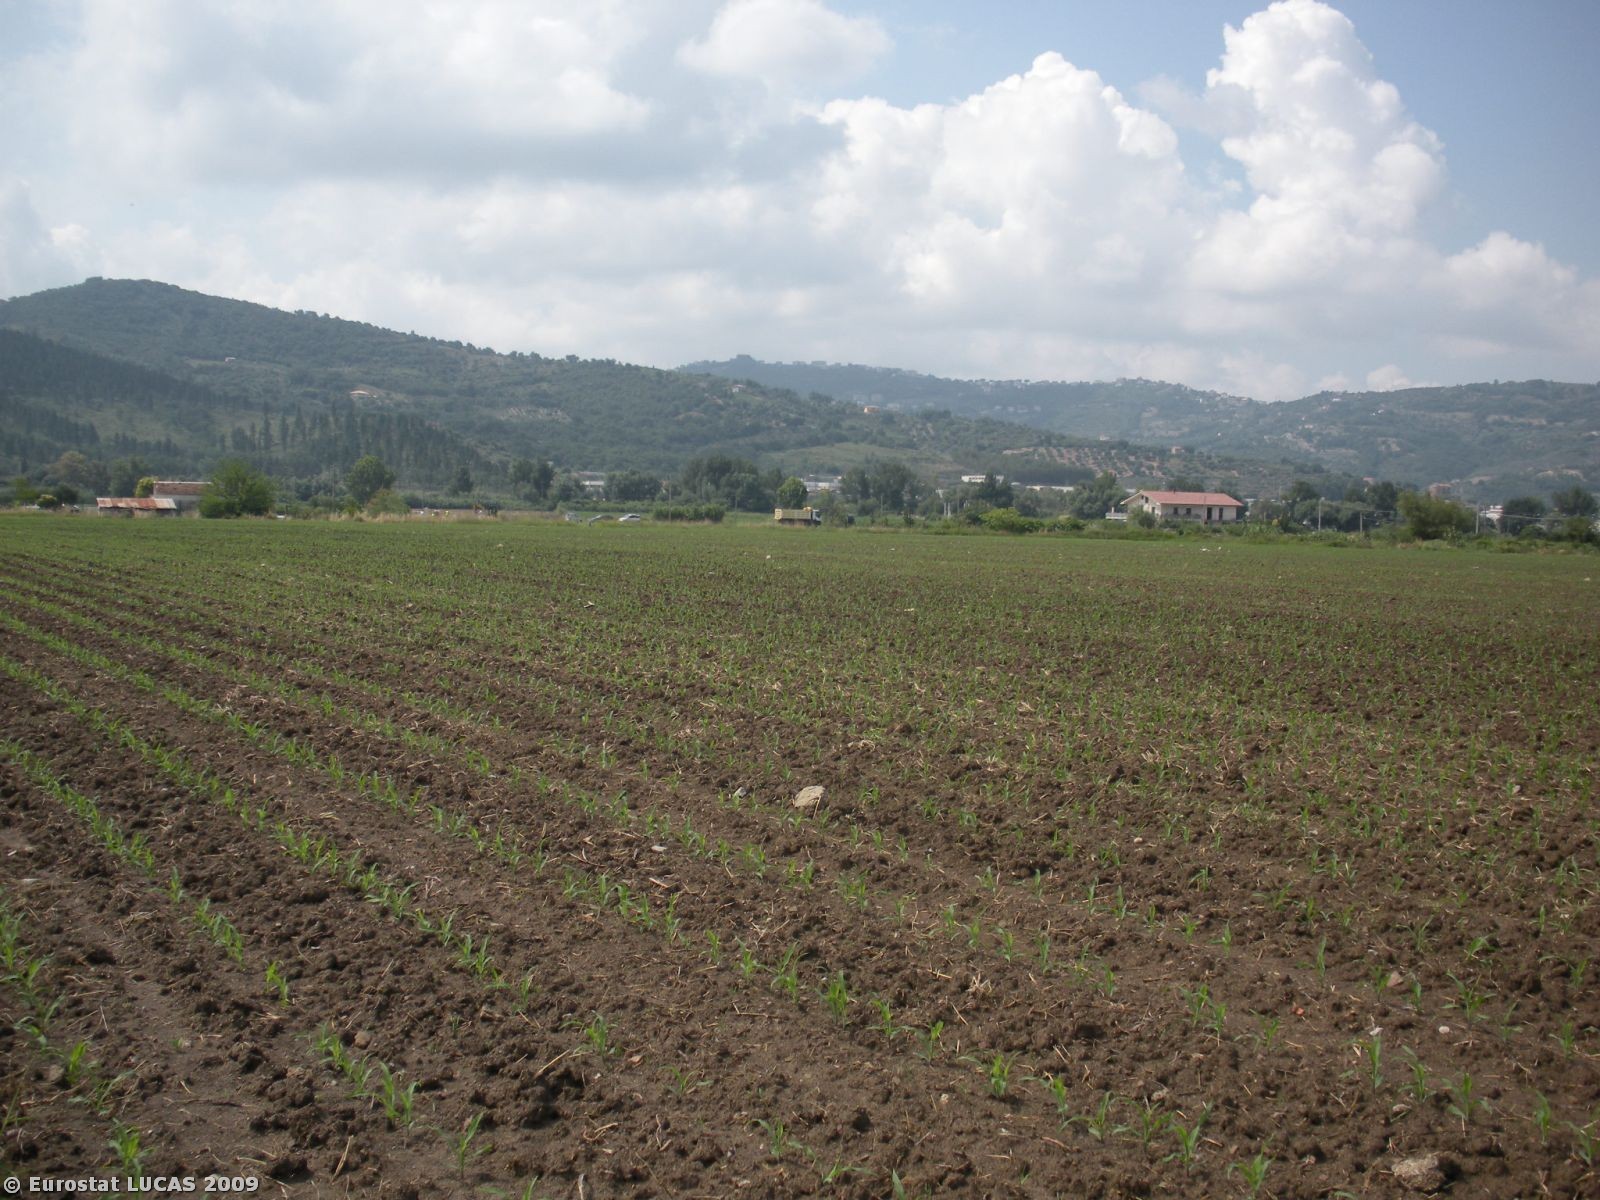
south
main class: Cropland
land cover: Maize
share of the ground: 10 - 25 %
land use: Agriculture (excluding fallow land and kitchen gardens)
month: July
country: IT
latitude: 40.3908
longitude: 15.0556
